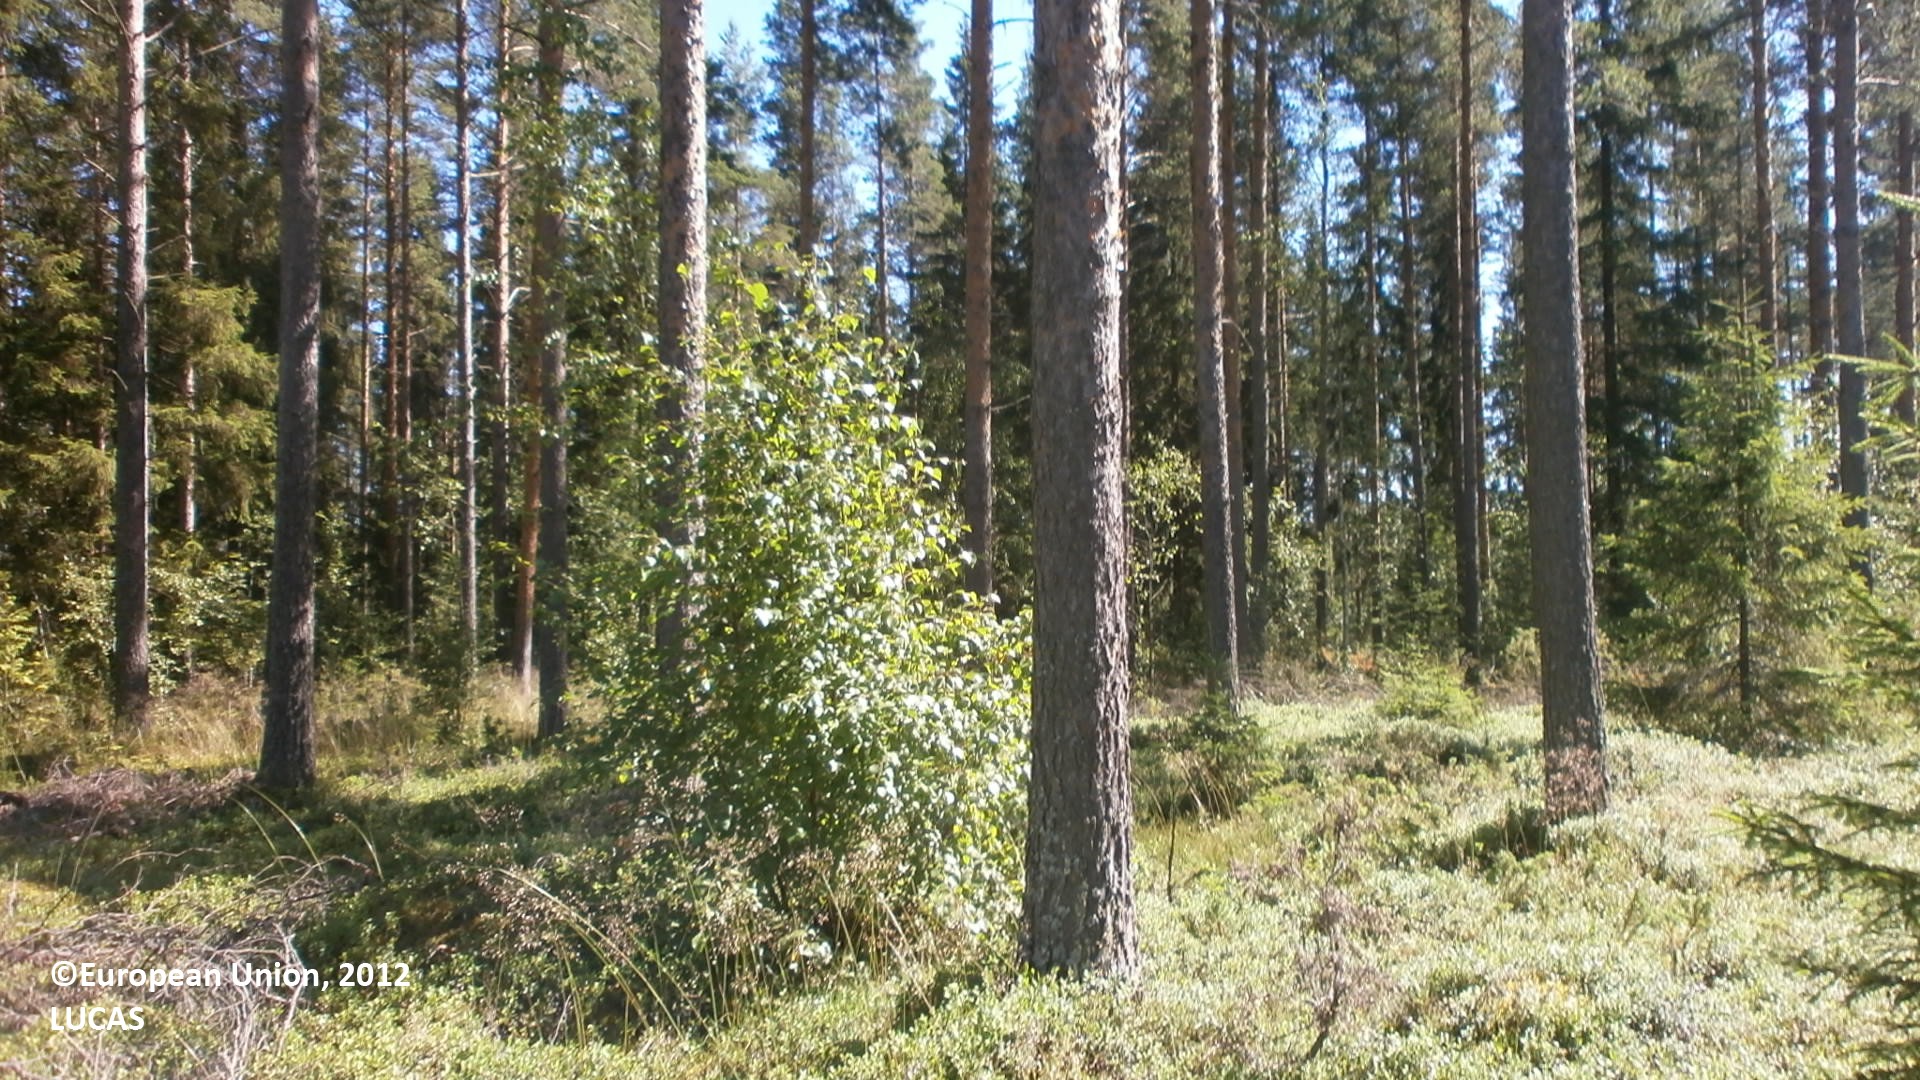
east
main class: Woodland
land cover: Pine dominated coniferous woodland
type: boreal forest
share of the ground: 50 - 75 %
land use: Forestry
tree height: > 5 m
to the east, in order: Pine dominated coniferous woodland; Spruce dominated coniferous woodland; Ditches and canals; Abandoned hedges; Temporary grasslands; Abandoned hedges; Ditches and canals; Shruby margins; Barley
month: July
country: FI
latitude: 64.1110
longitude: 24.3368
